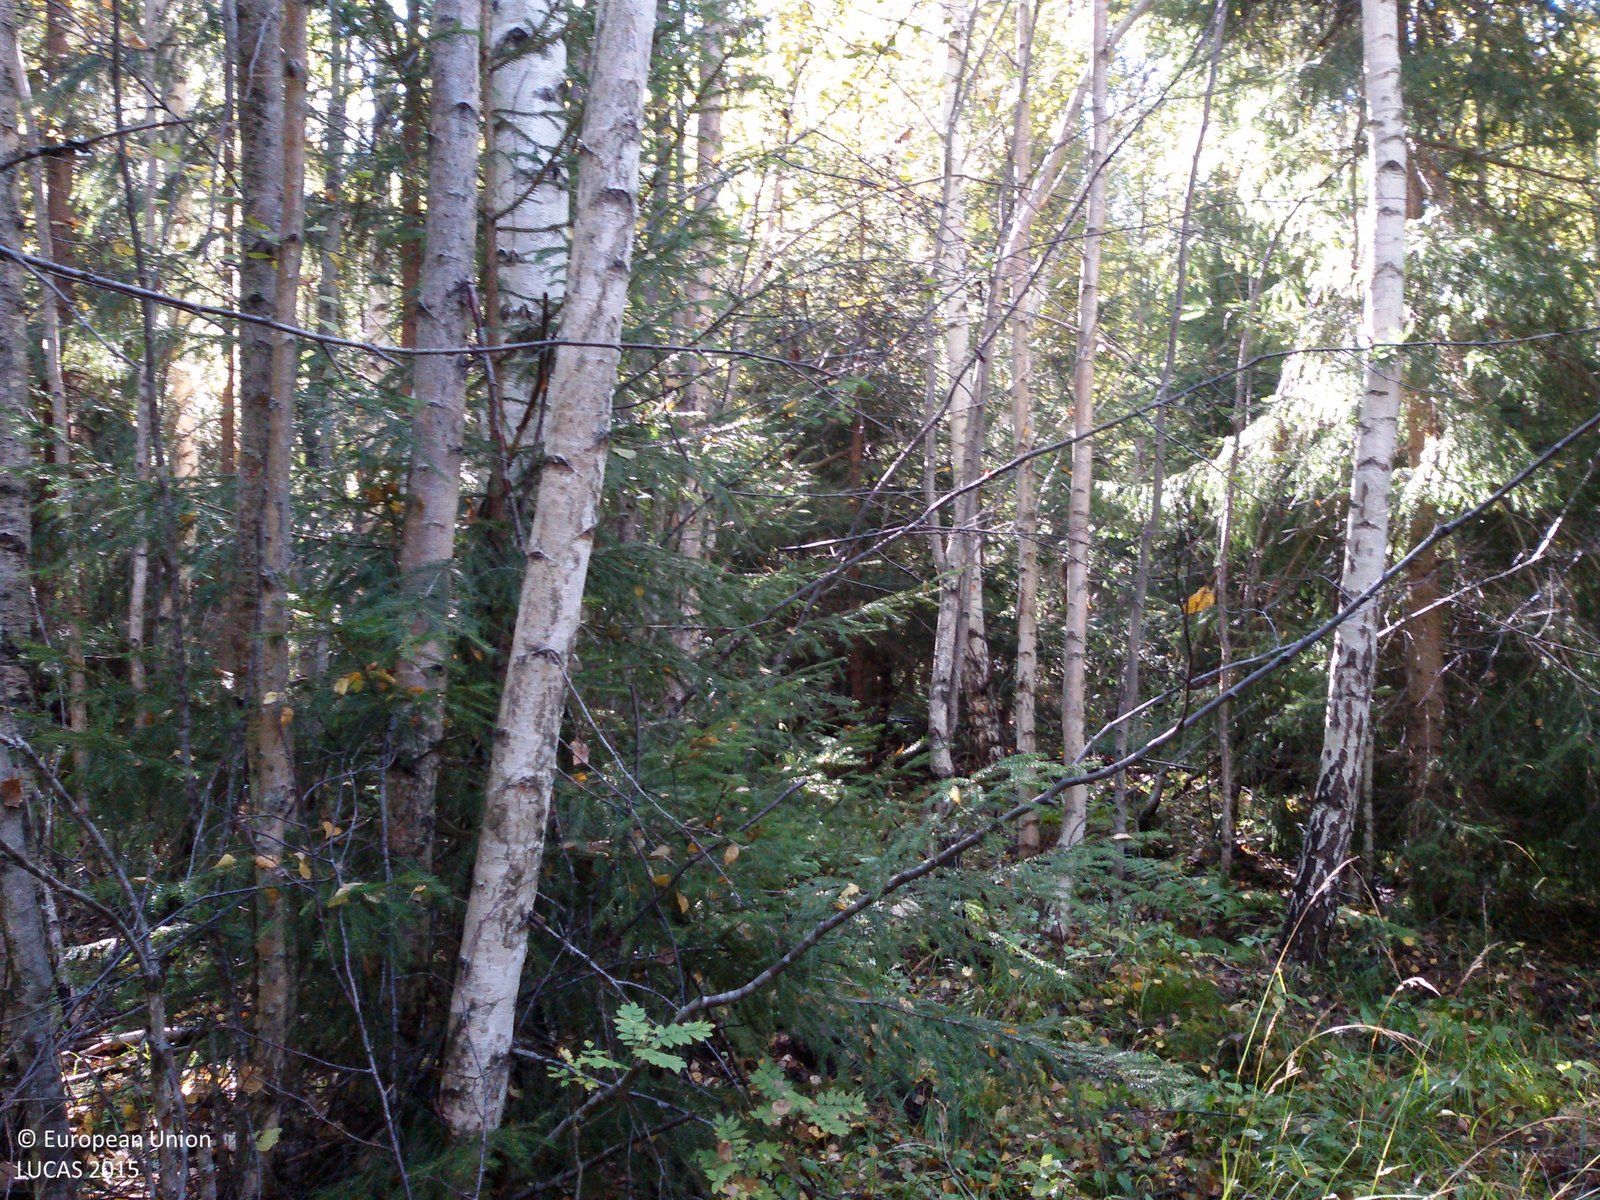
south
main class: Woodland
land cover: Spruce dominated mixed woodland
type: boreal forest
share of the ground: > 75 %
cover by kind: coniferous forest trees 45 %, broadleaved forest trees 45 %, herbaceous plants 5 %, lichens and mosses 5 %
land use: Forestry
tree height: > 5 m
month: September
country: SE
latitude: 60.7517
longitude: 14.7026
